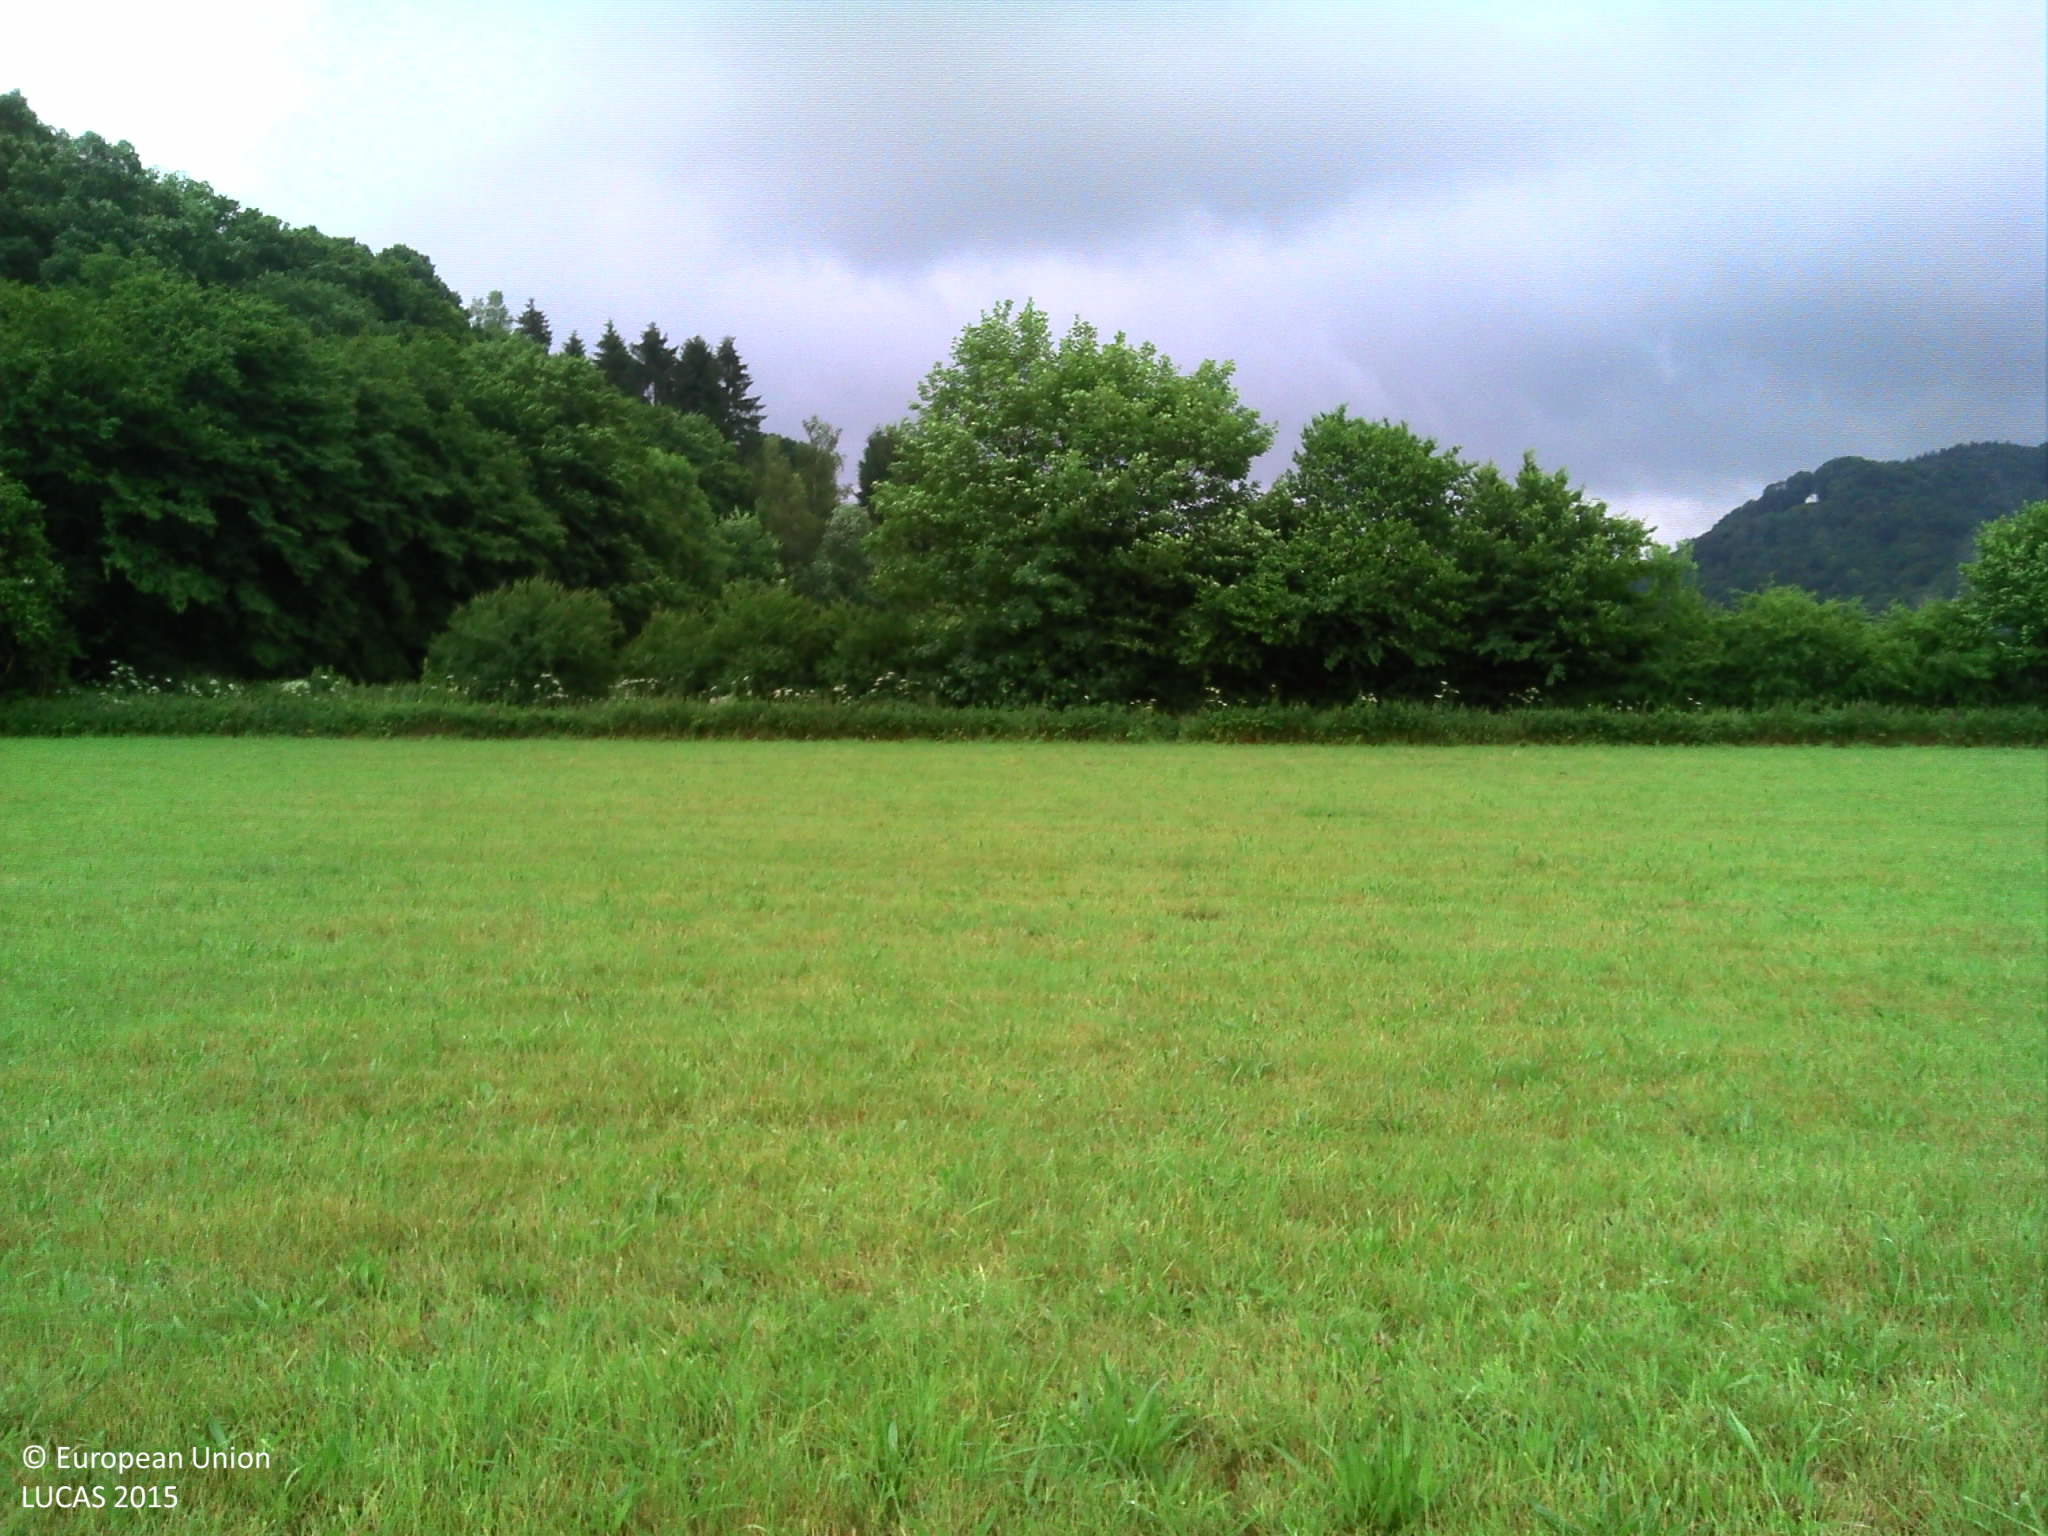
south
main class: Grassland
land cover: Grassland without tree/shrub cover
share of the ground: > 75 %
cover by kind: herbaceous plants 100 %
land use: Agriculture (excluding fallow land and kitchen gardens)
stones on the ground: < 10 %
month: June
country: BE
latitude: 50.2226
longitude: 5.5272
